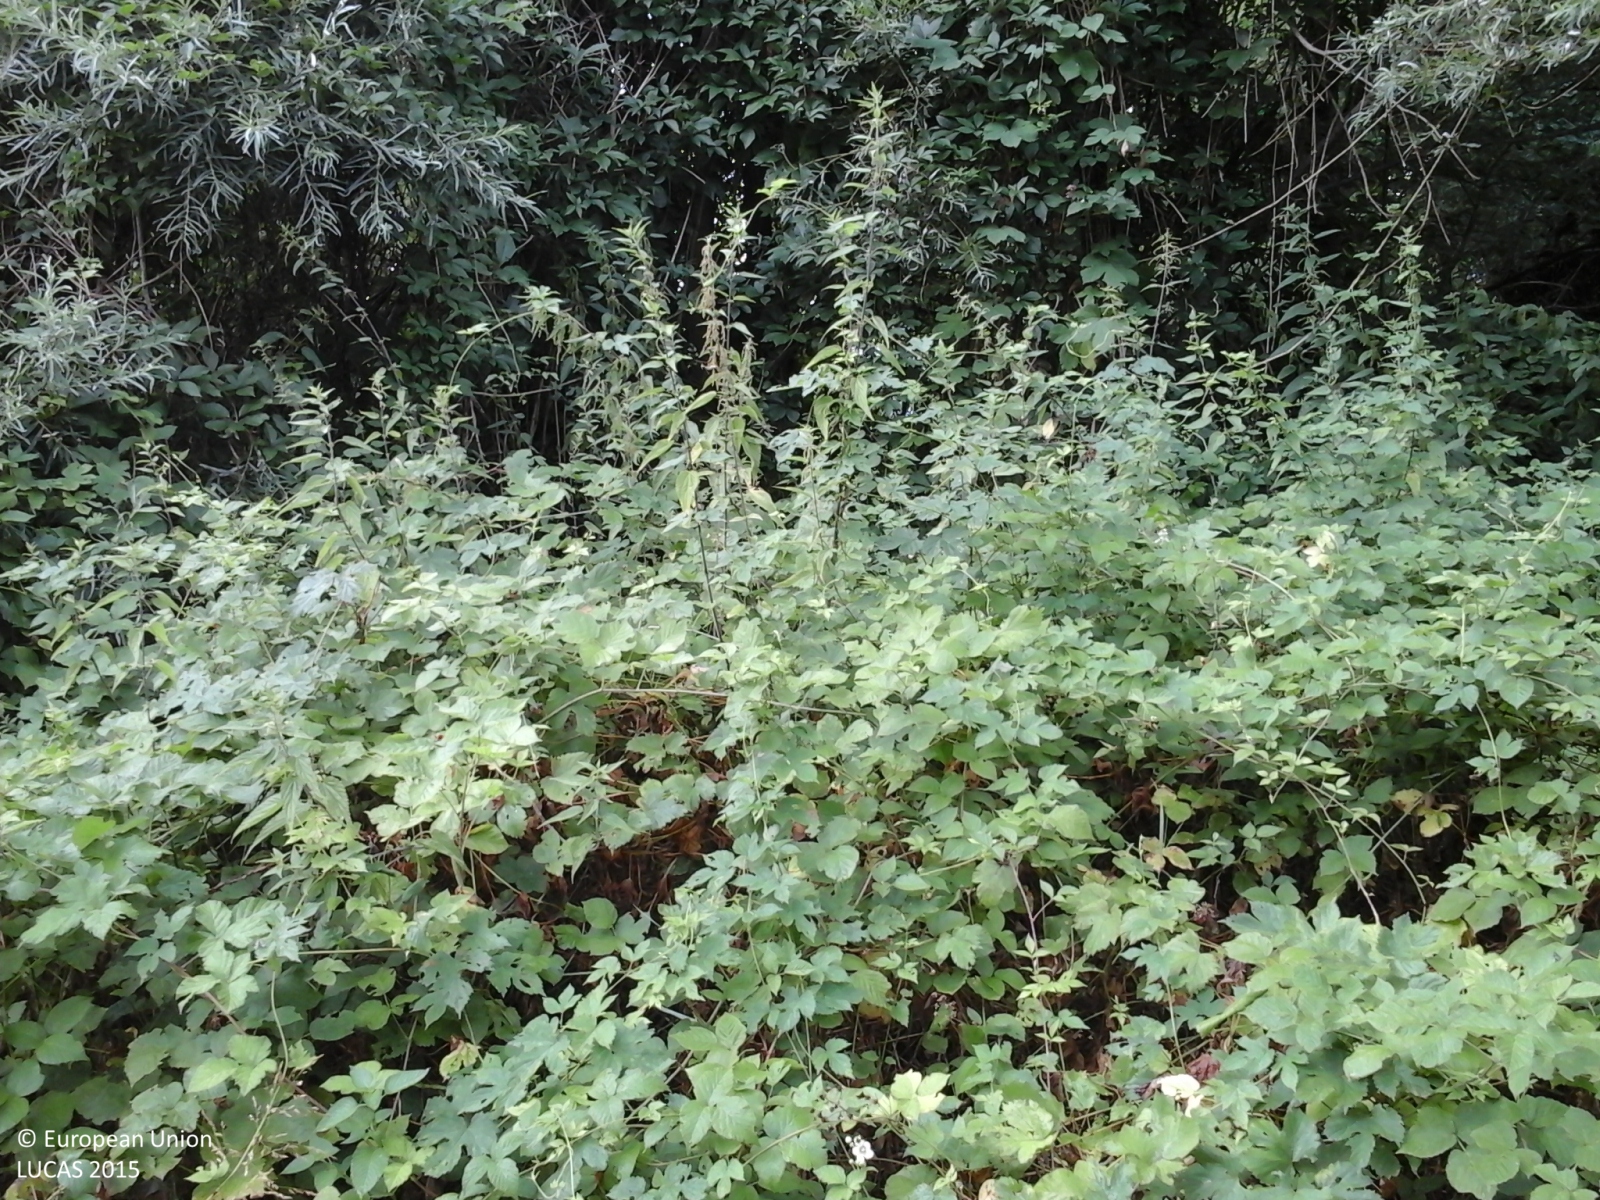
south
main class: Woodland
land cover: Broadleaved woodland
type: thermophilous deciduous forest
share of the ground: > 75 %
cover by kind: broadleaved forest trees 80 %, shrubs 20 %
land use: Semi-natural and natural areas not in use
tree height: > 5 m
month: July
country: IT
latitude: 44.6588
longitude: 7.3189
